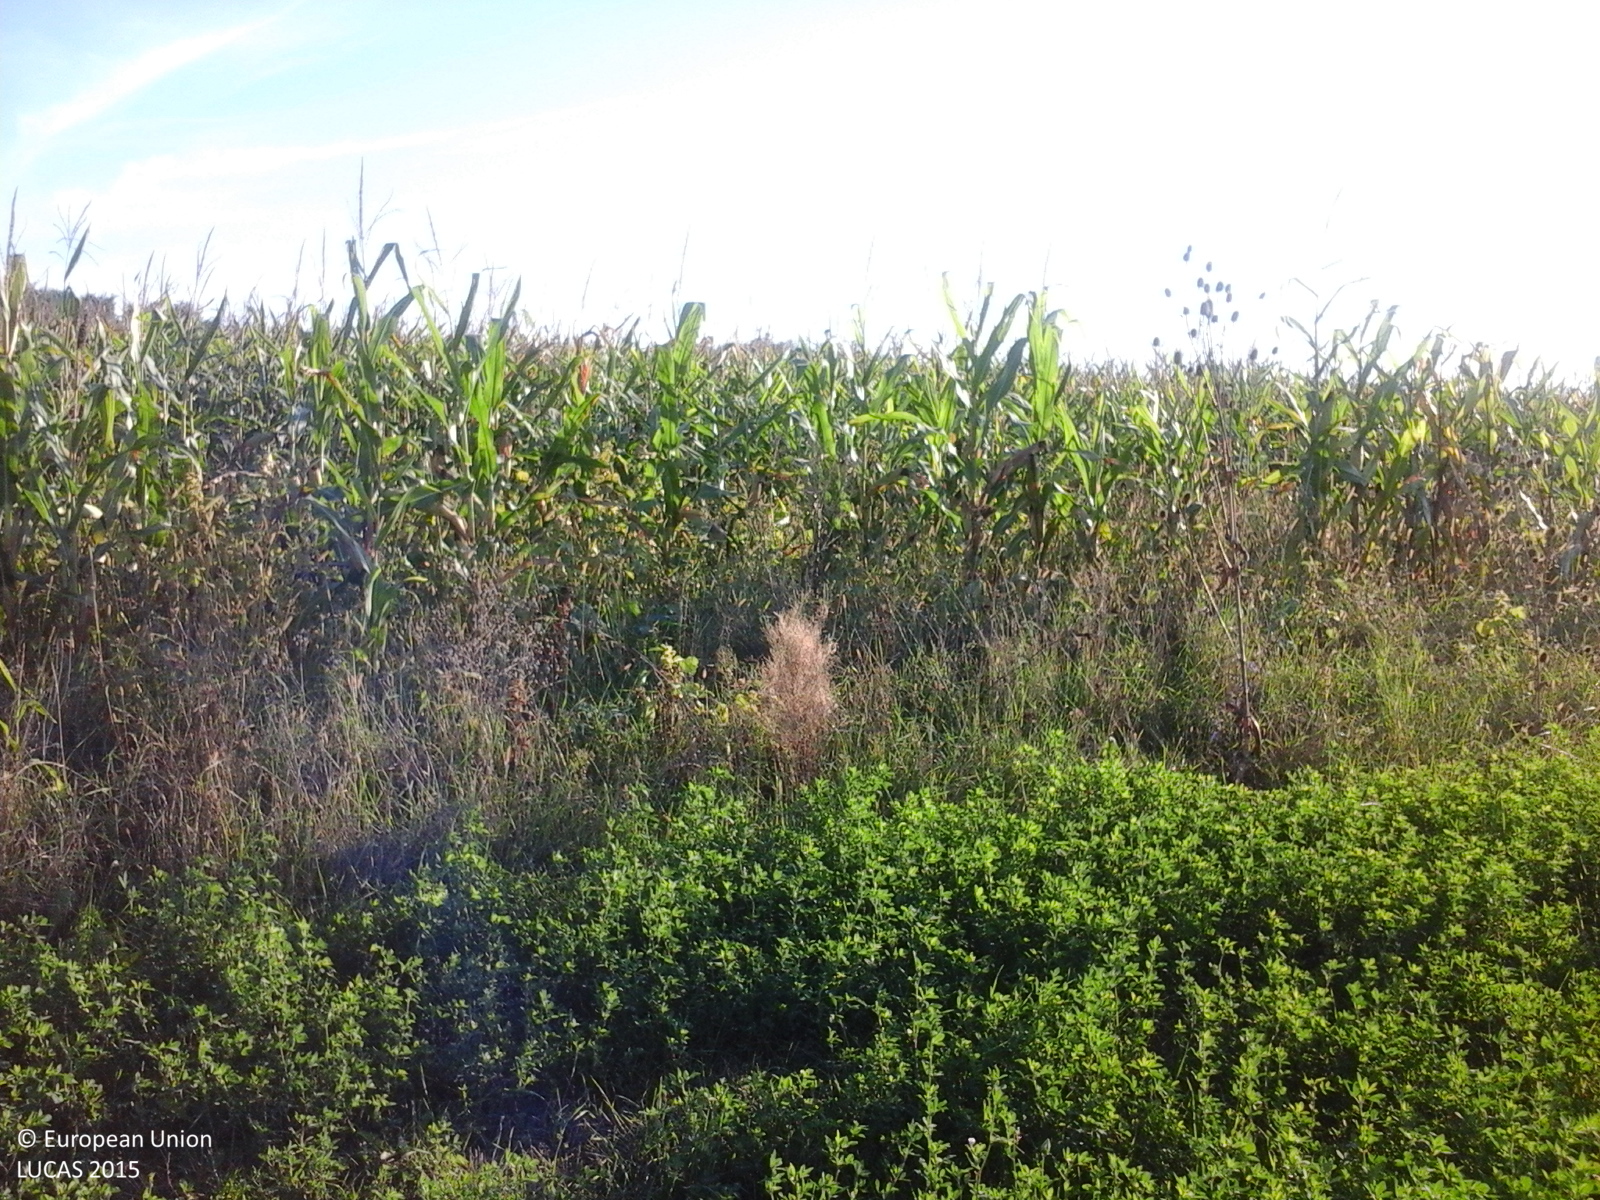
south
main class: Cropland
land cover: Lucerne
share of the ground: > 75 %
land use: Agriculture (excluding fallow land and kitchen gardens)
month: October
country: RO
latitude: 46.2127
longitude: 23.9831
